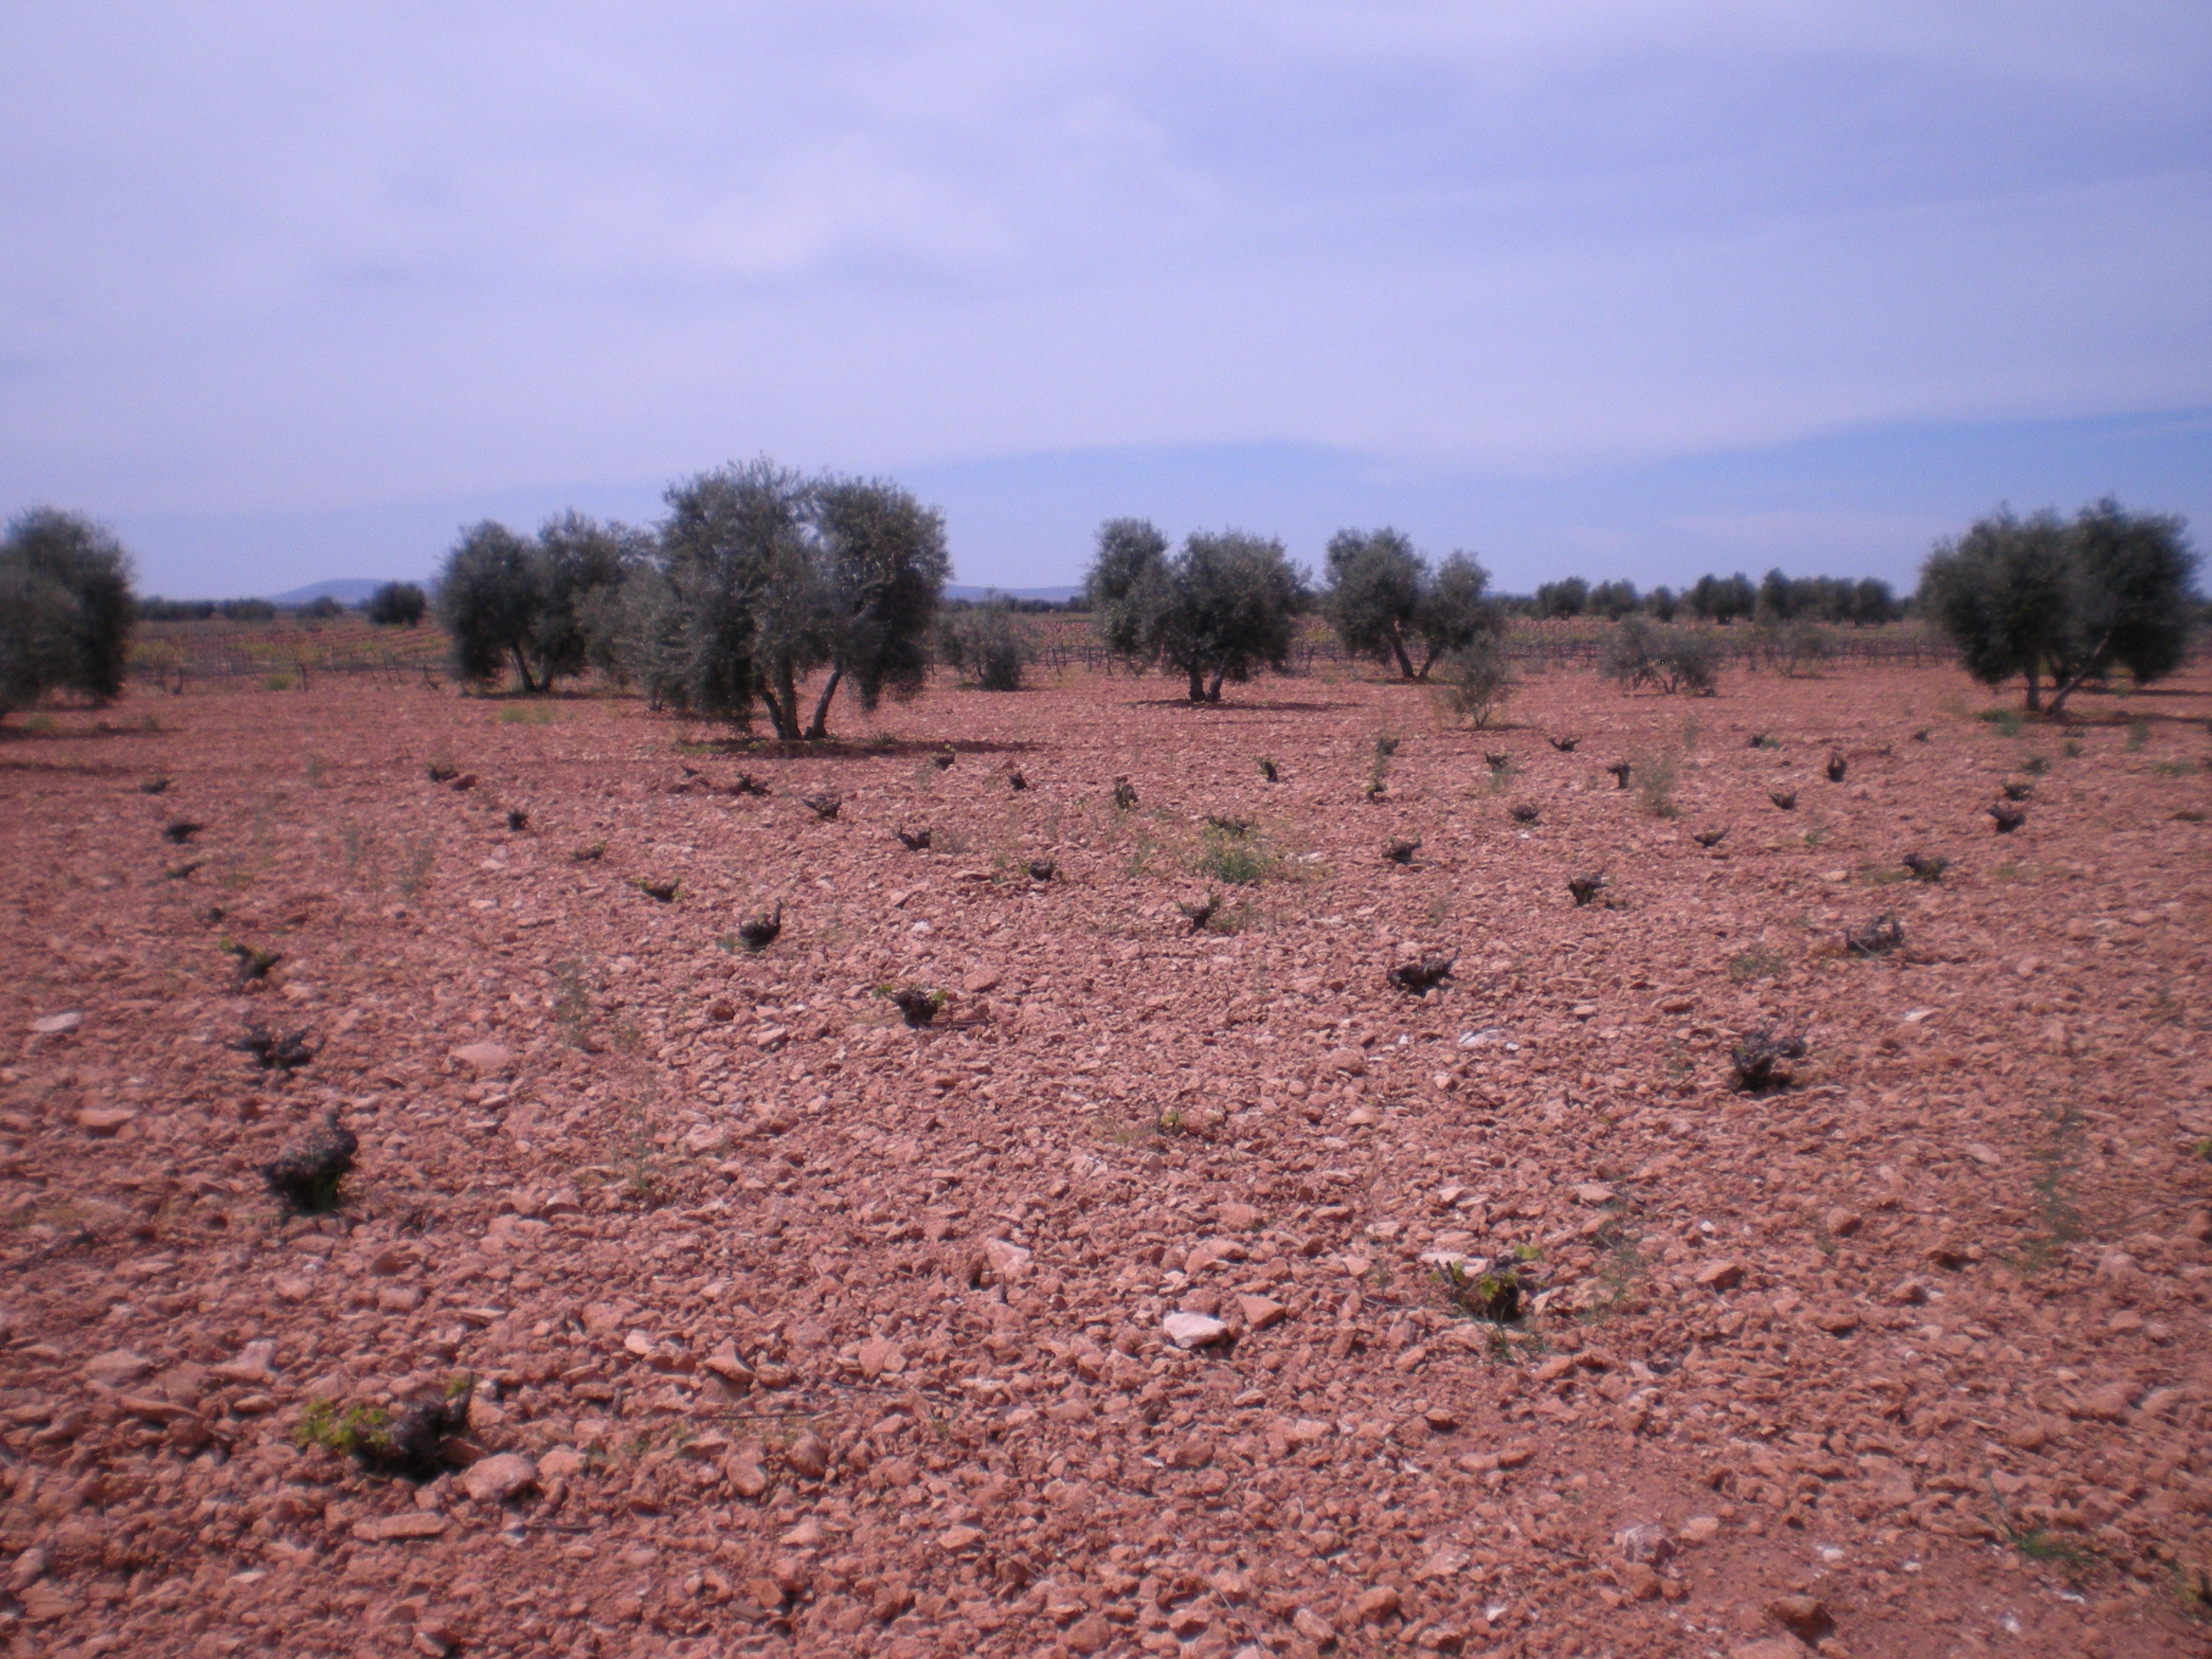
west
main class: Cropland
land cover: Vineyards
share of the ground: < 10 %
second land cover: Other bare soil
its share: > 75 %
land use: Agriculture (excluding fallow land and kitchen gardens)
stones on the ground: < 10 %
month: April
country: ES
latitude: 38.8692
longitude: -3.2539
